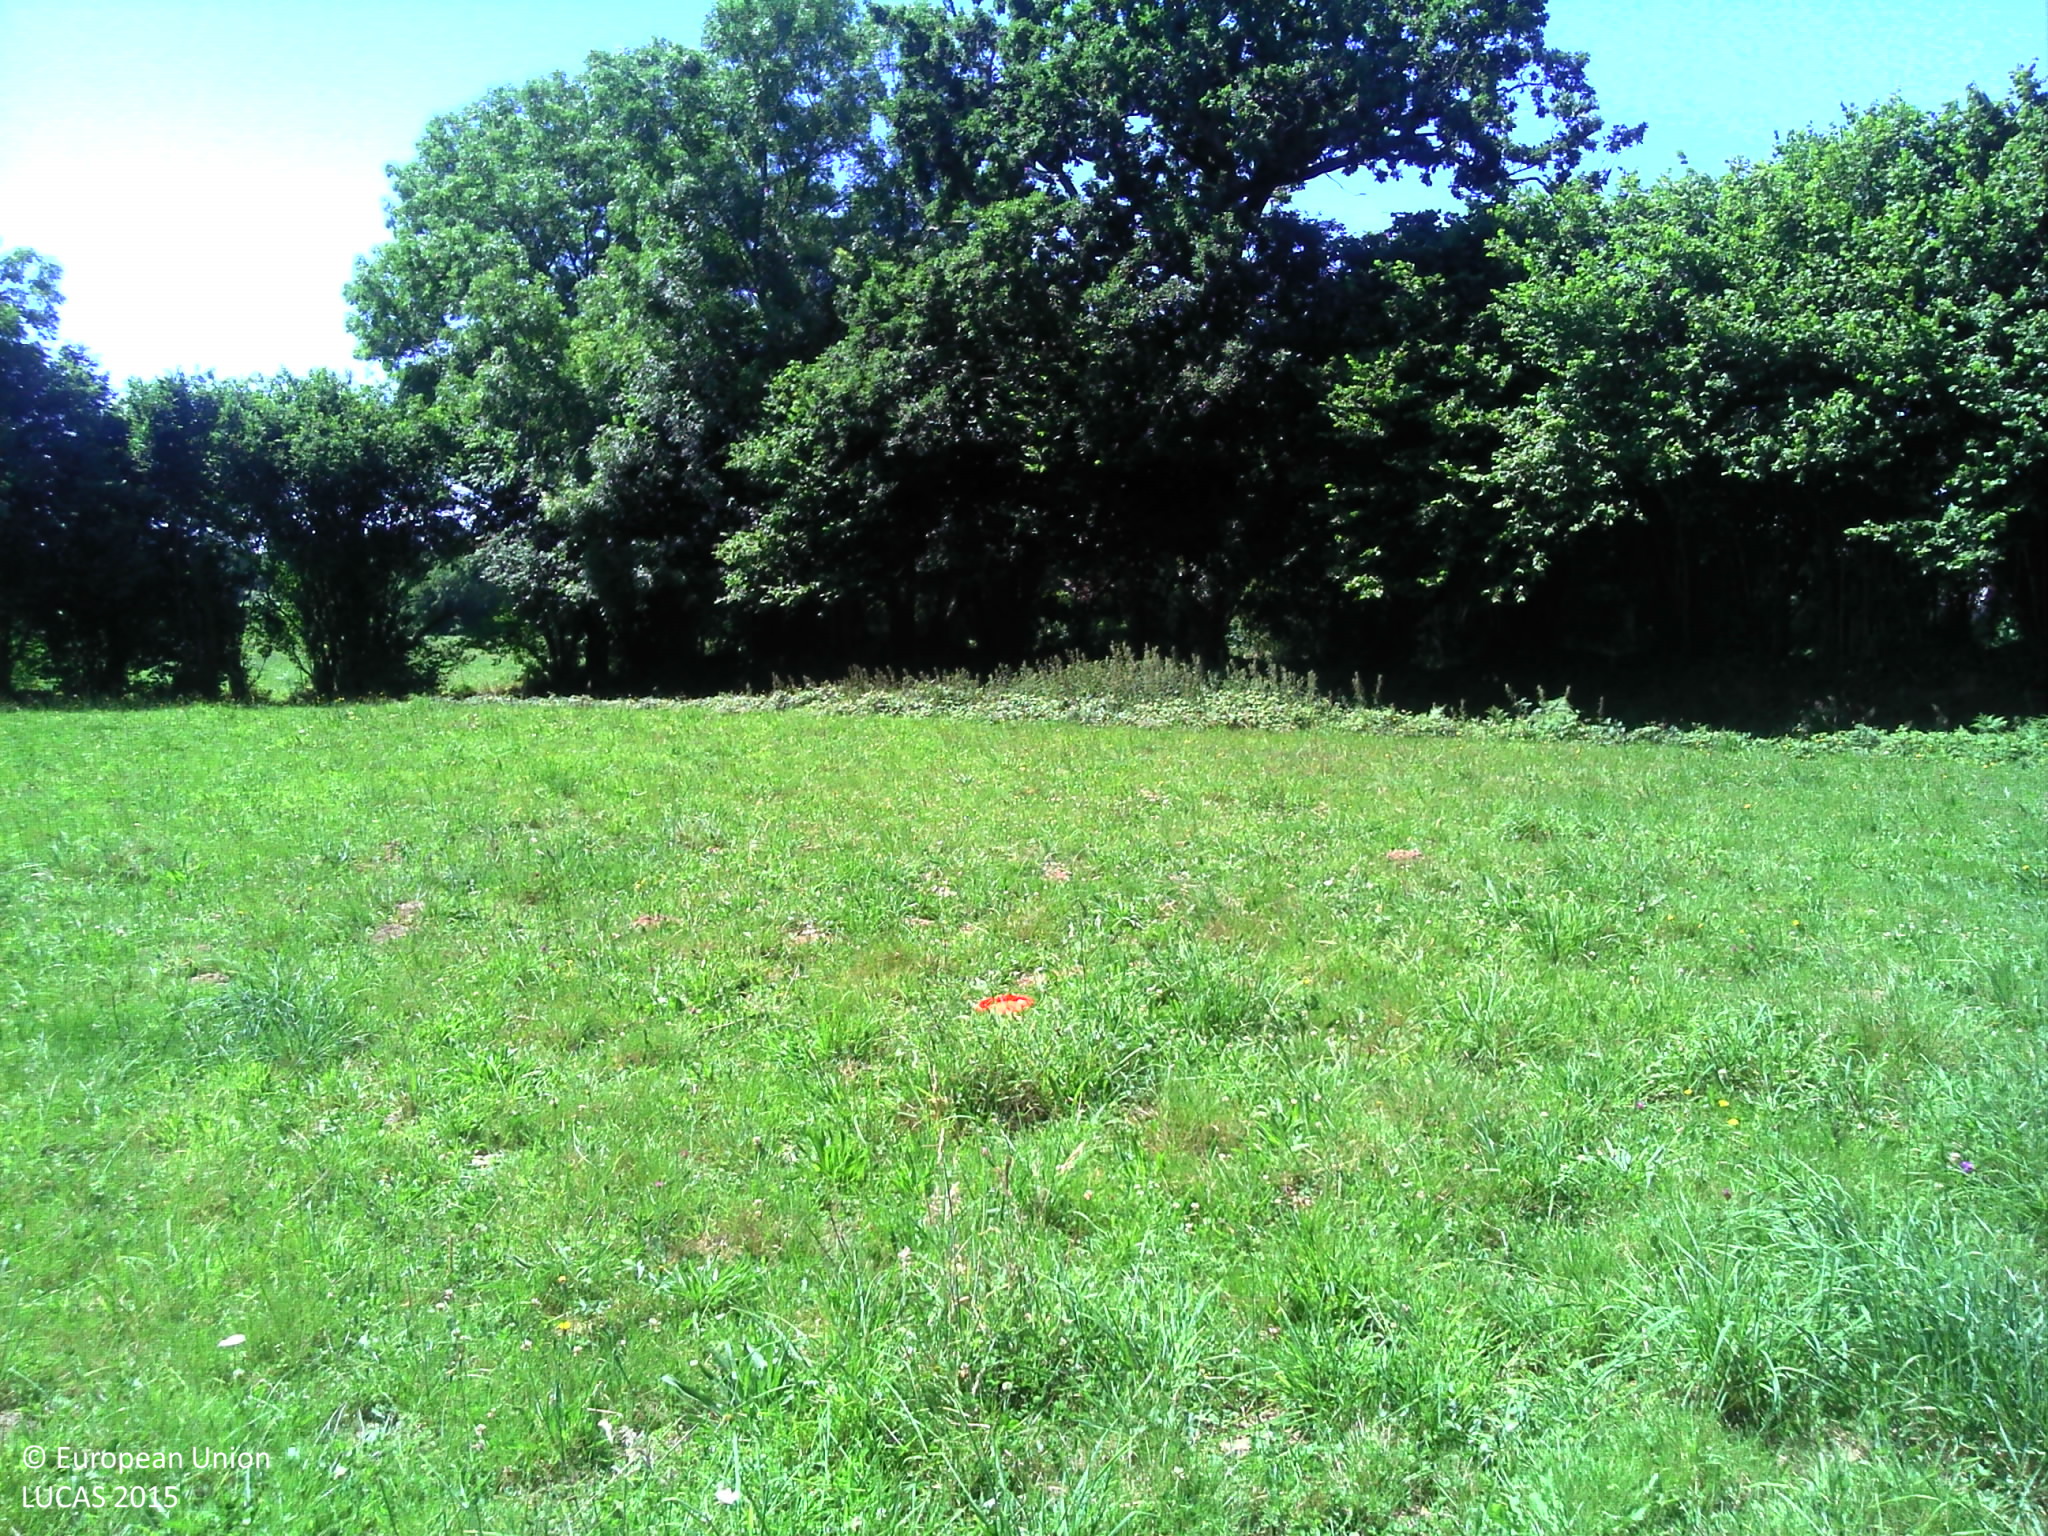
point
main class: Grassland
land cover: Grassland without tree/shrub cover
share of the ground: > 75 %
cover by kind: herbaceous plants 100 %
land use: Agriculture (excluding fallow land and kitchen gardens)
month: July
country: FR
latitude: 49.0566
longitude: -1.3083
